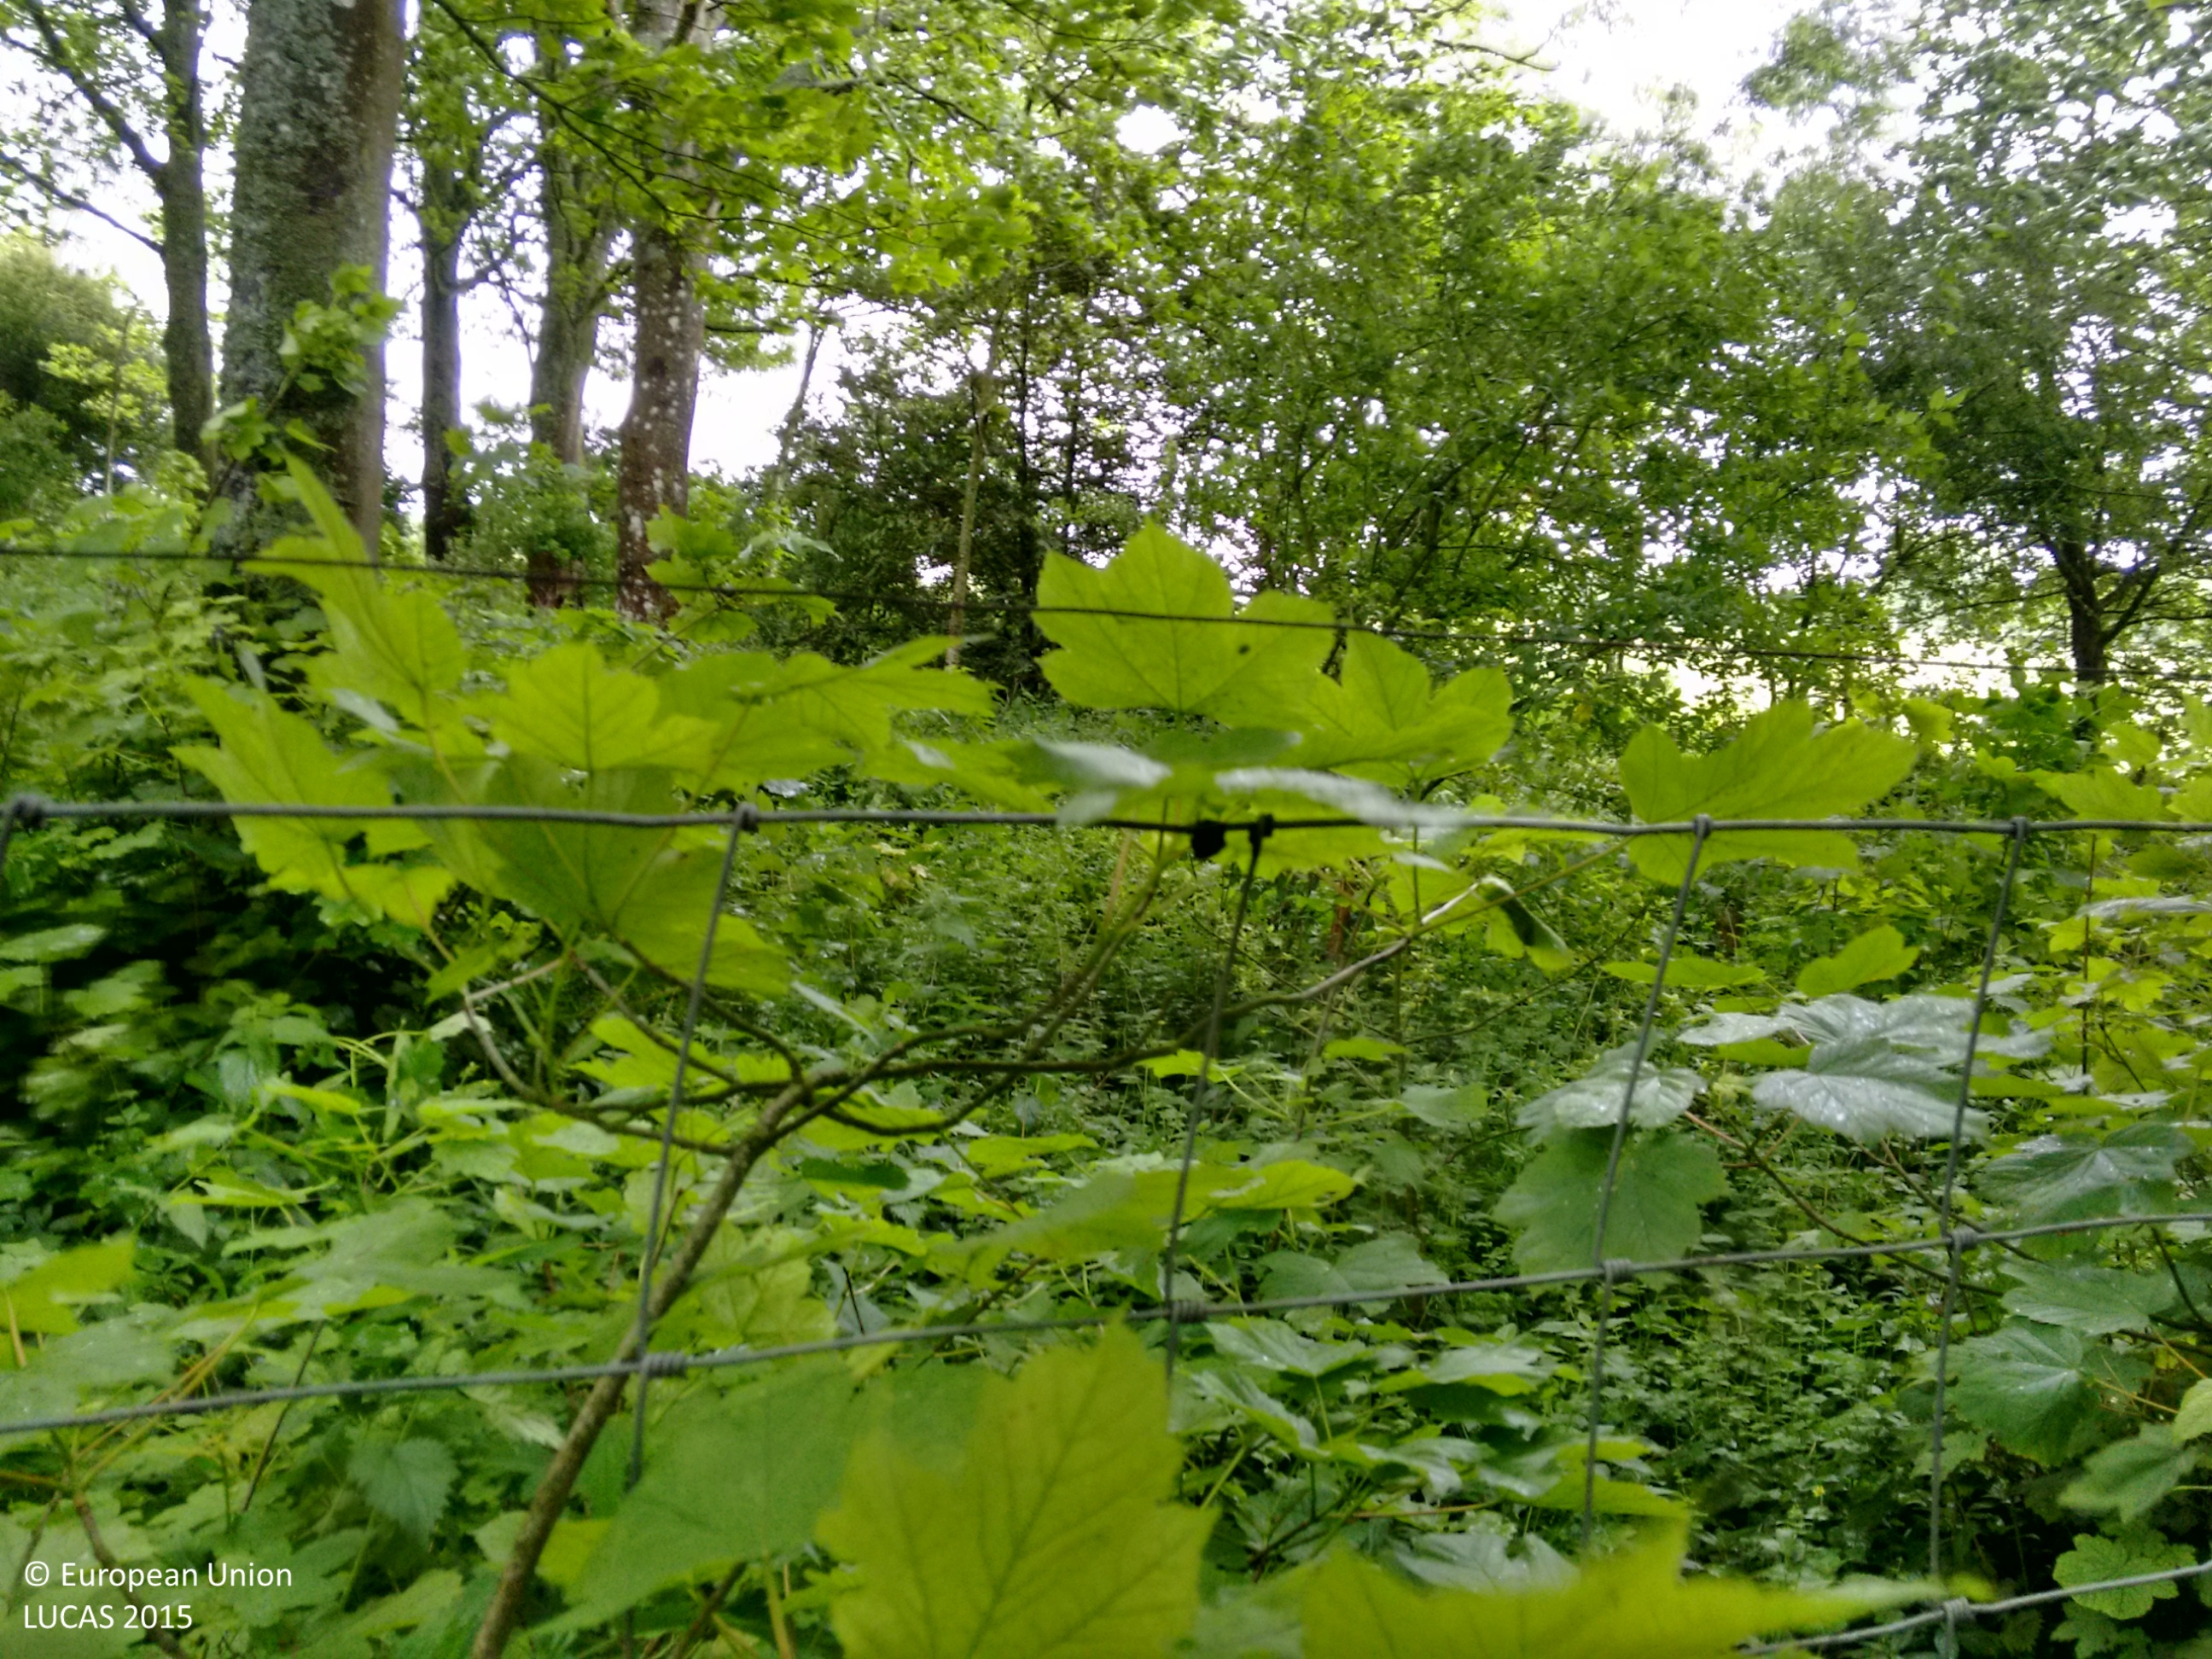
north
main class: Woodland
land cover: Broadleaved woodland
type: mesophytic deciduous forest
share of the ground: > 75 %
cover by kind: broadleaved forest trees 90 %, shrubs 10 %
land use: Agriculture (excluding fallow land and kitchen gardens)
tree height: > 5 m
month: June
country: GB
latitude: 51.1598
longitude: -1.1568
